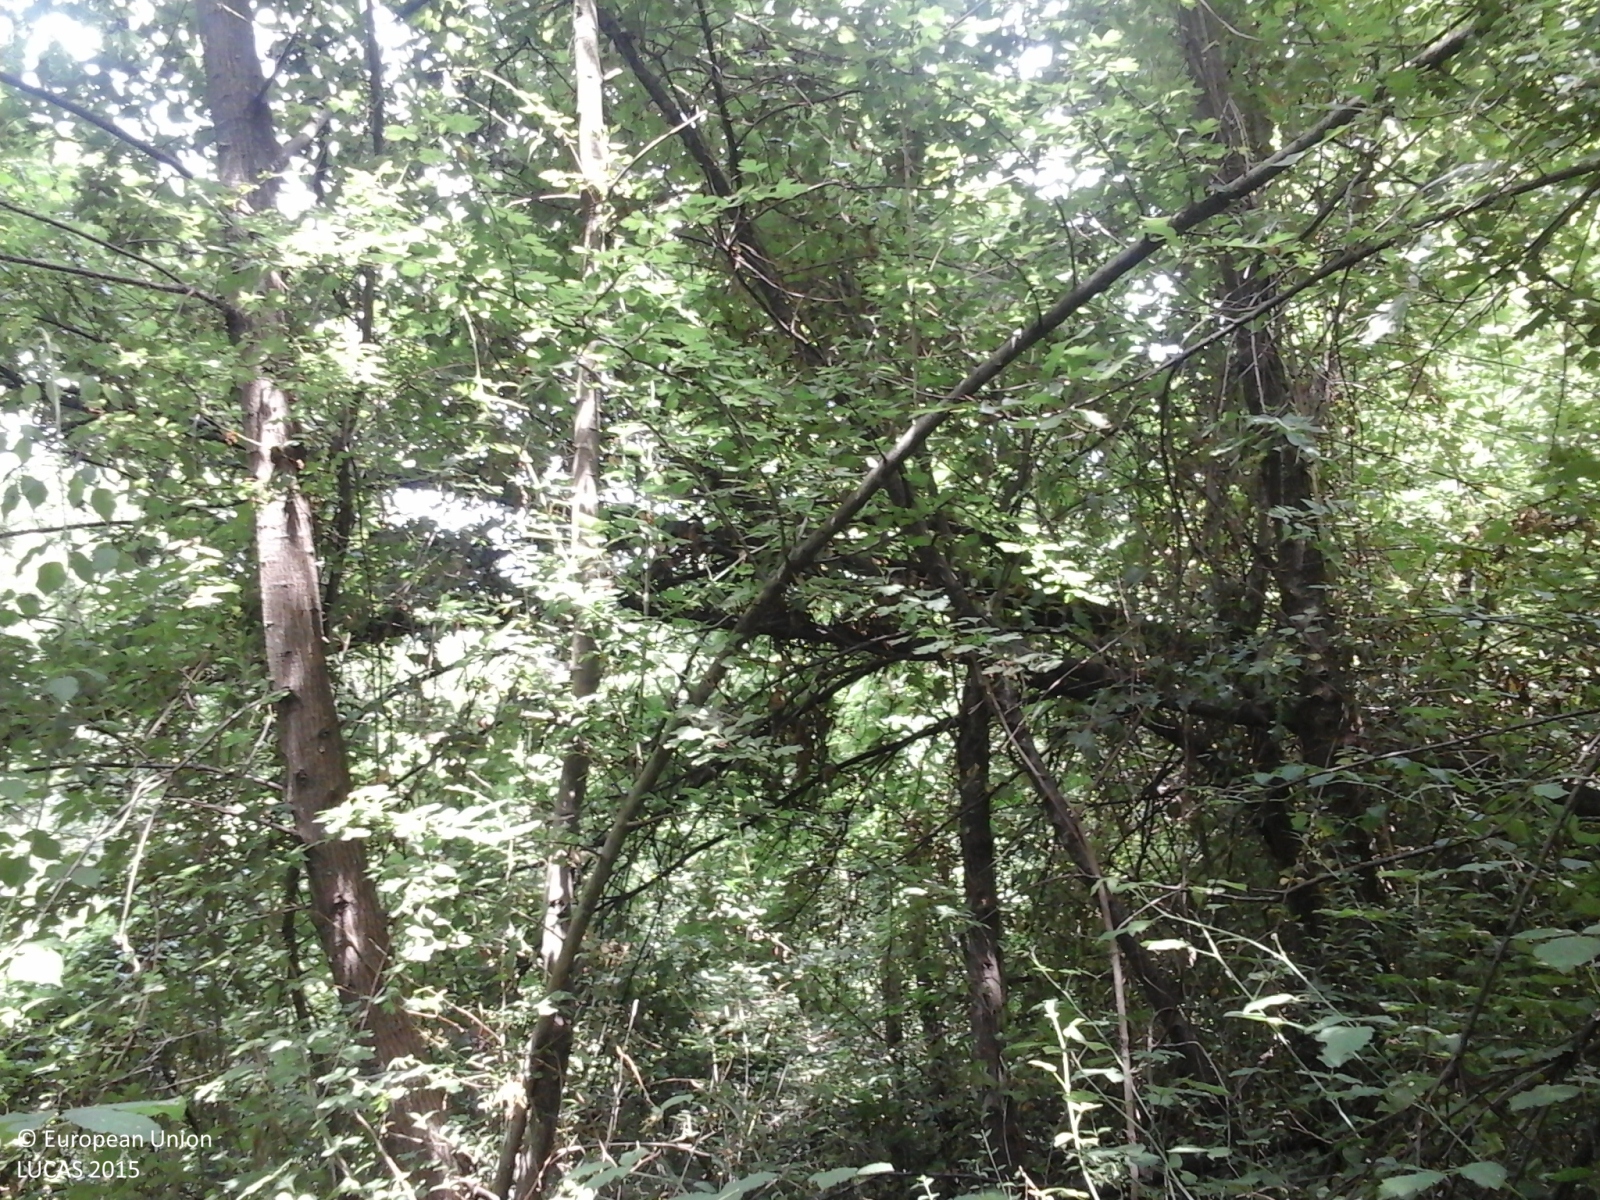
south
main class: Woodland
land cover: Broadleaved woodland
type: thermophilous deciduous forest
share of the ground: > 75 %
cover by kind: broadleaved forest trees 90 %, shrubs 10 %
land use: Forestry
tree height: < 5 m
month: June
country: IT
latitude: 41.6038
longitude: 13.3589
